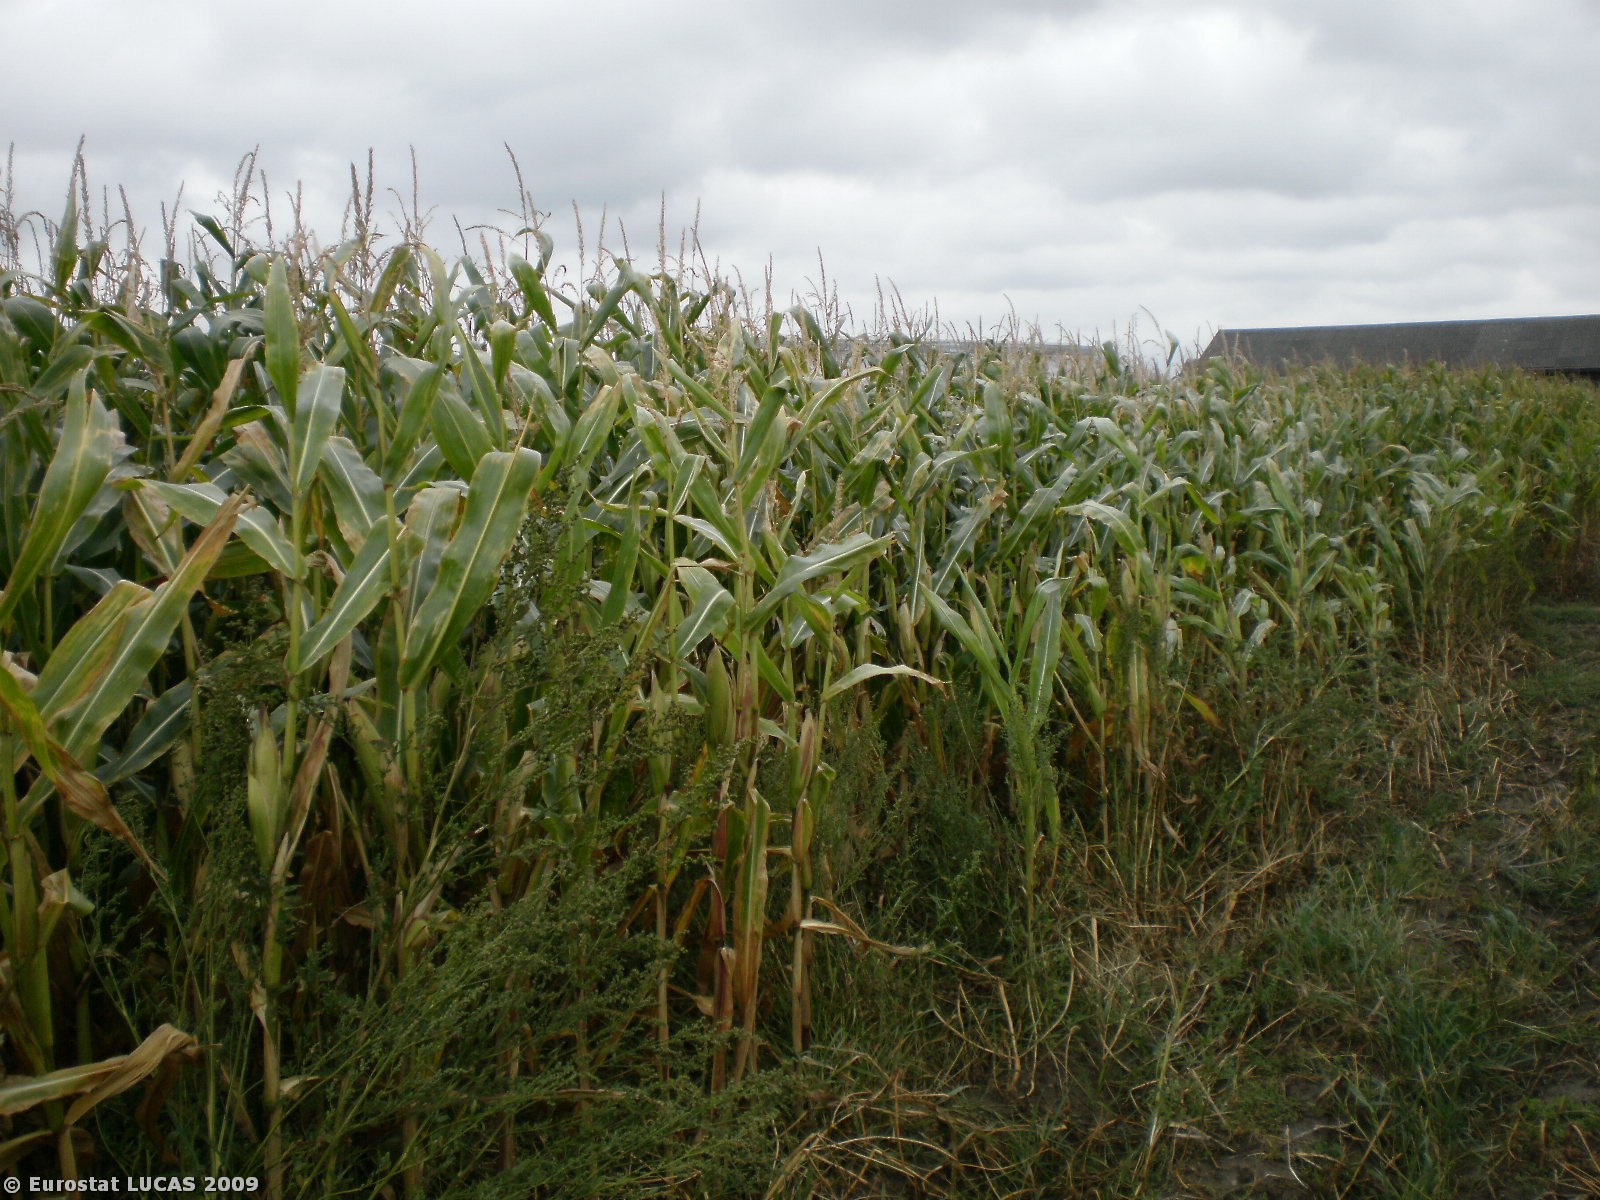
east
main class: Cropland
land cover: Maize
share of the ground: > 75 %
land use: Agriculture (excluding fallow land and kitchen gardens)
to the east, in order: Maize; Grassland without tree/shrub cover; Artificial constructions in urban areas
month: September
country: PL
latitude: 53.8756
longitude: 17.7548
